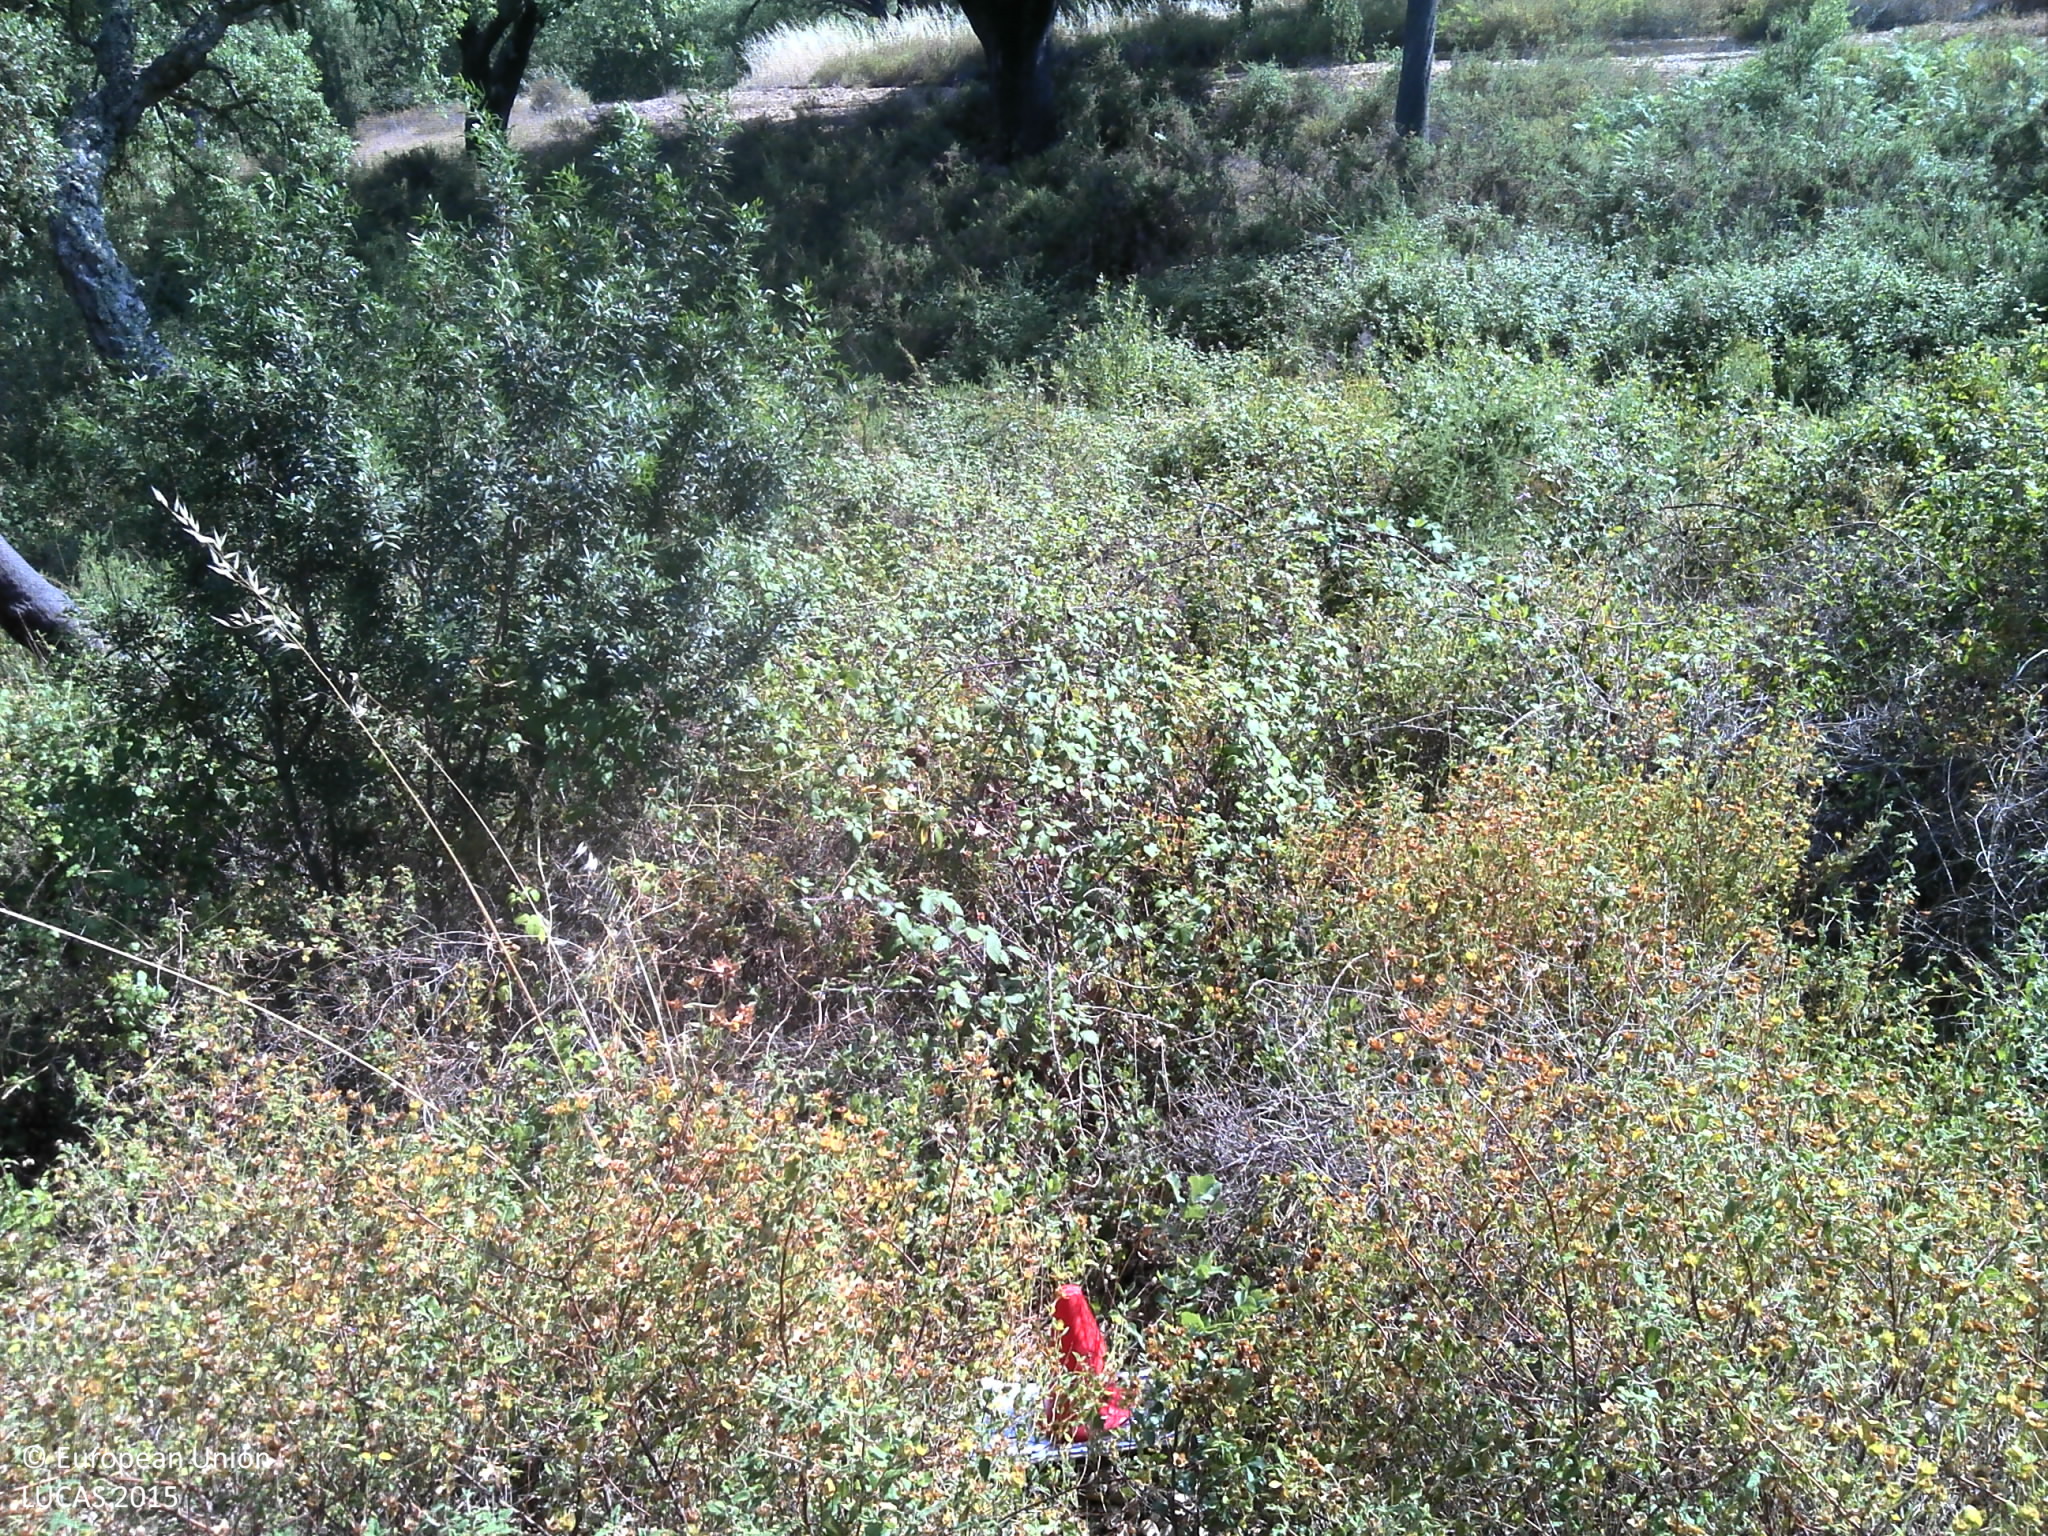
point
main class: Woodland
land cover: Broadleaved woodland
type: broadleaved evergreen forest
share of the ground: 25 - 50 %
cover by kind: shrubs 50 %, broadleaved forest trees 40 %, consolidated bare surface 10 %
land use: Forestry
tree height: > 5 m
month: May
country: PT
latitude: 38.0123
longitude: -8.3895
